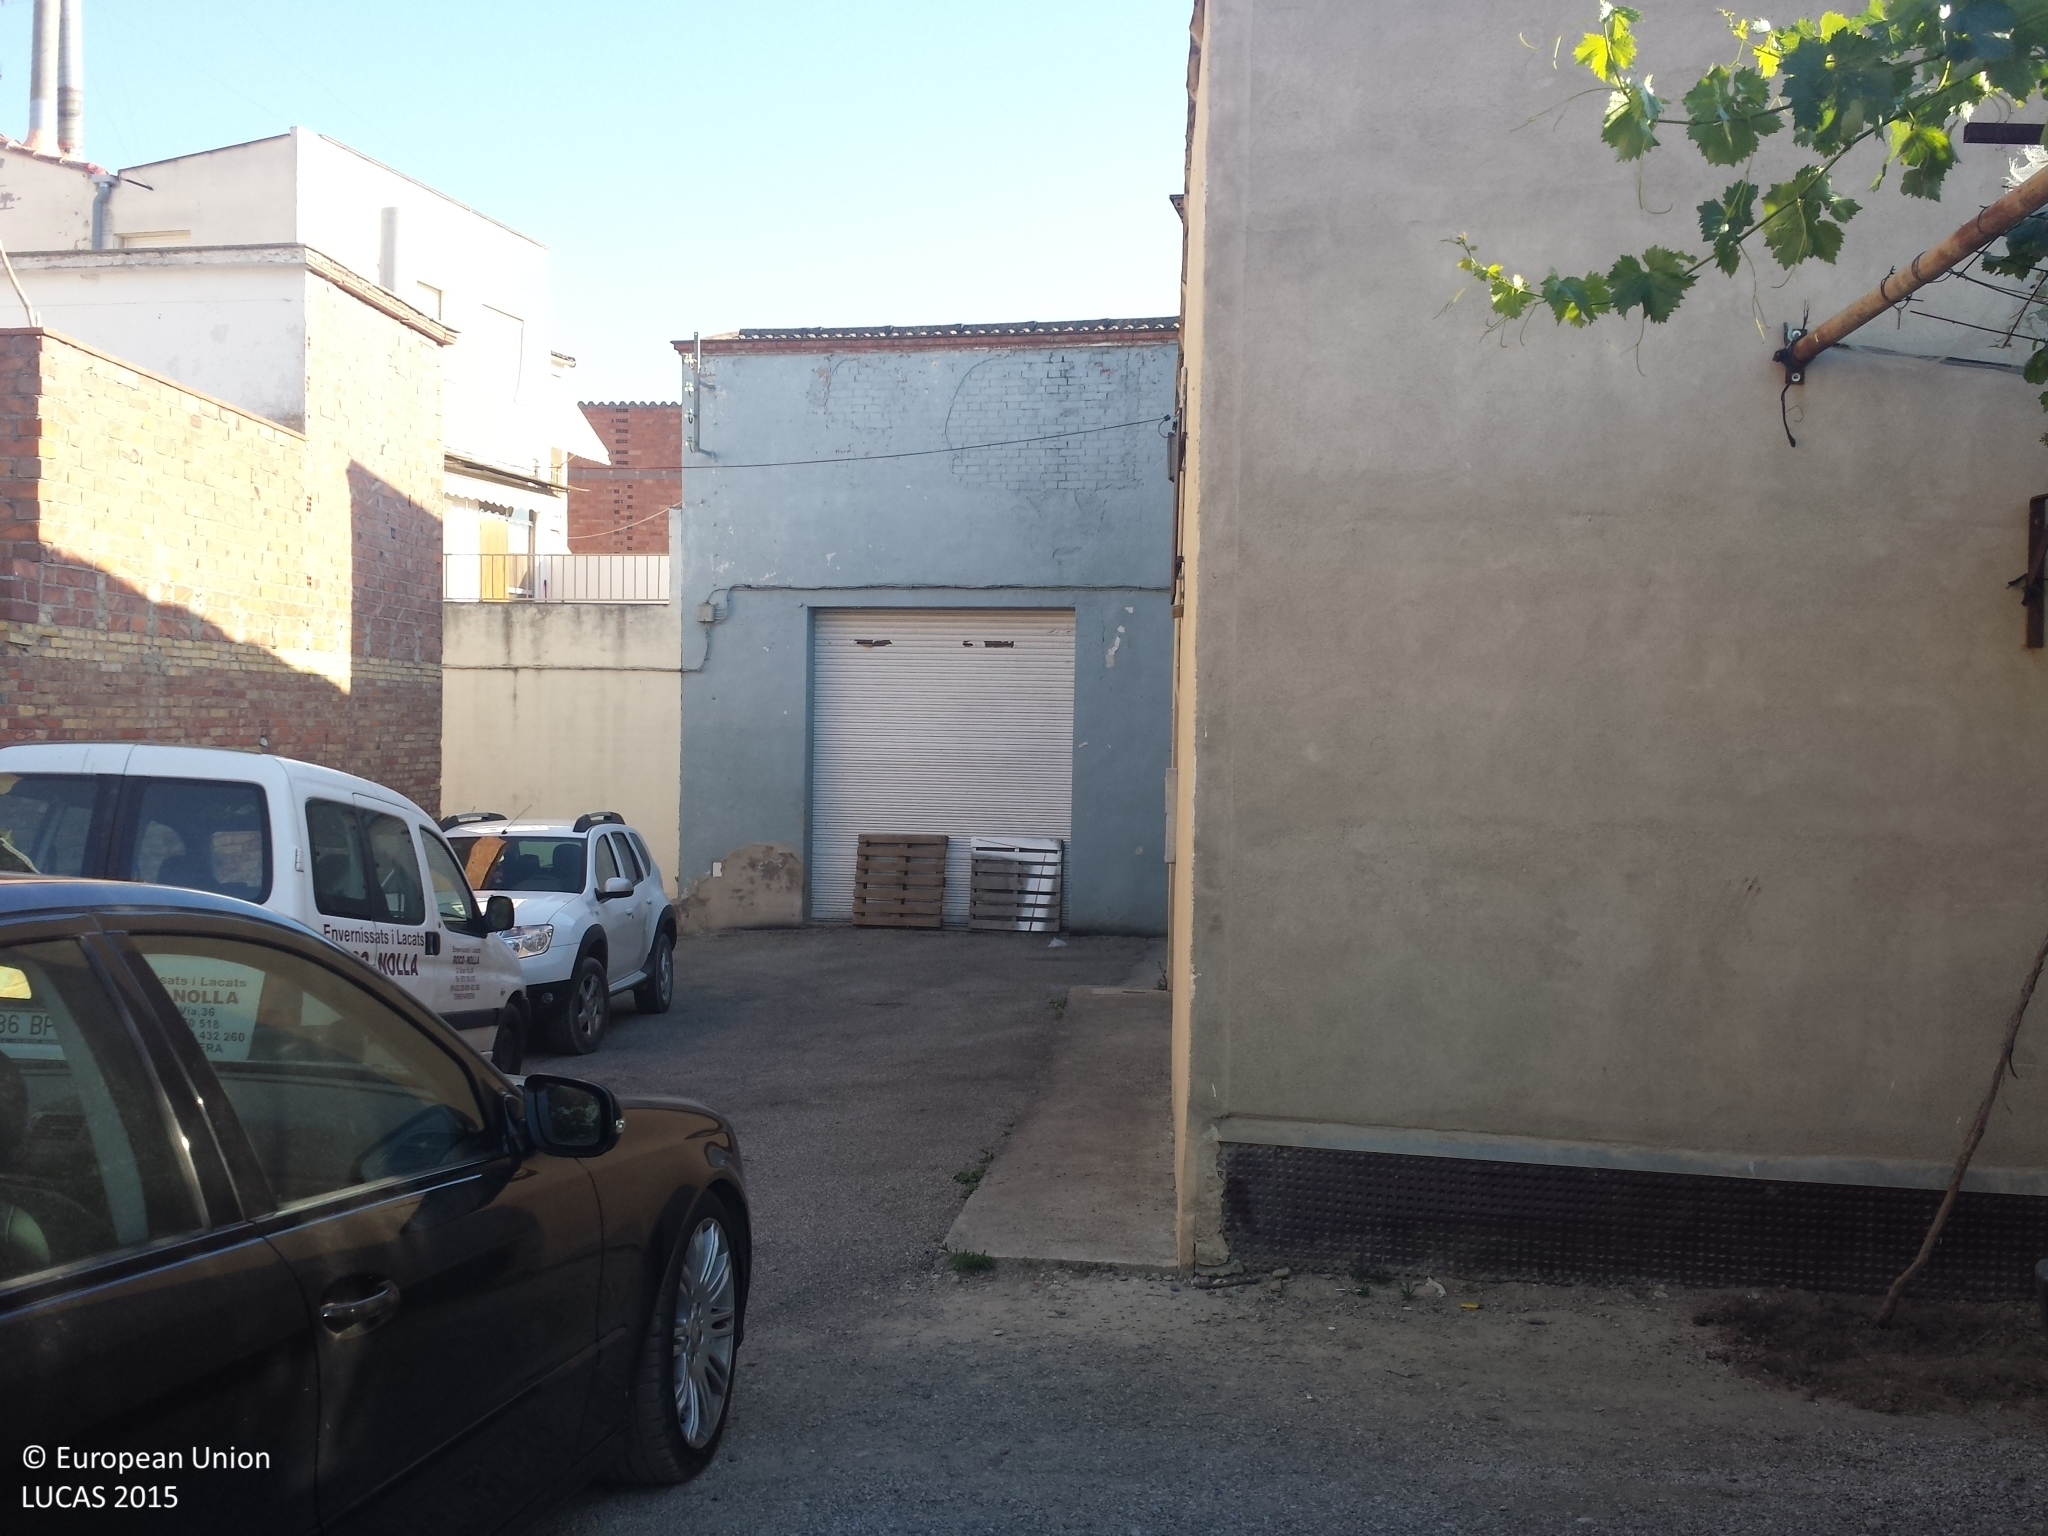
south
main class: Cropland
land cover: Tomatoes
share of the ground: 50 - 75 %
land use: Kitchen garden
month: May
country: ES
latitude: 41.6714
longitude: 0.6064
